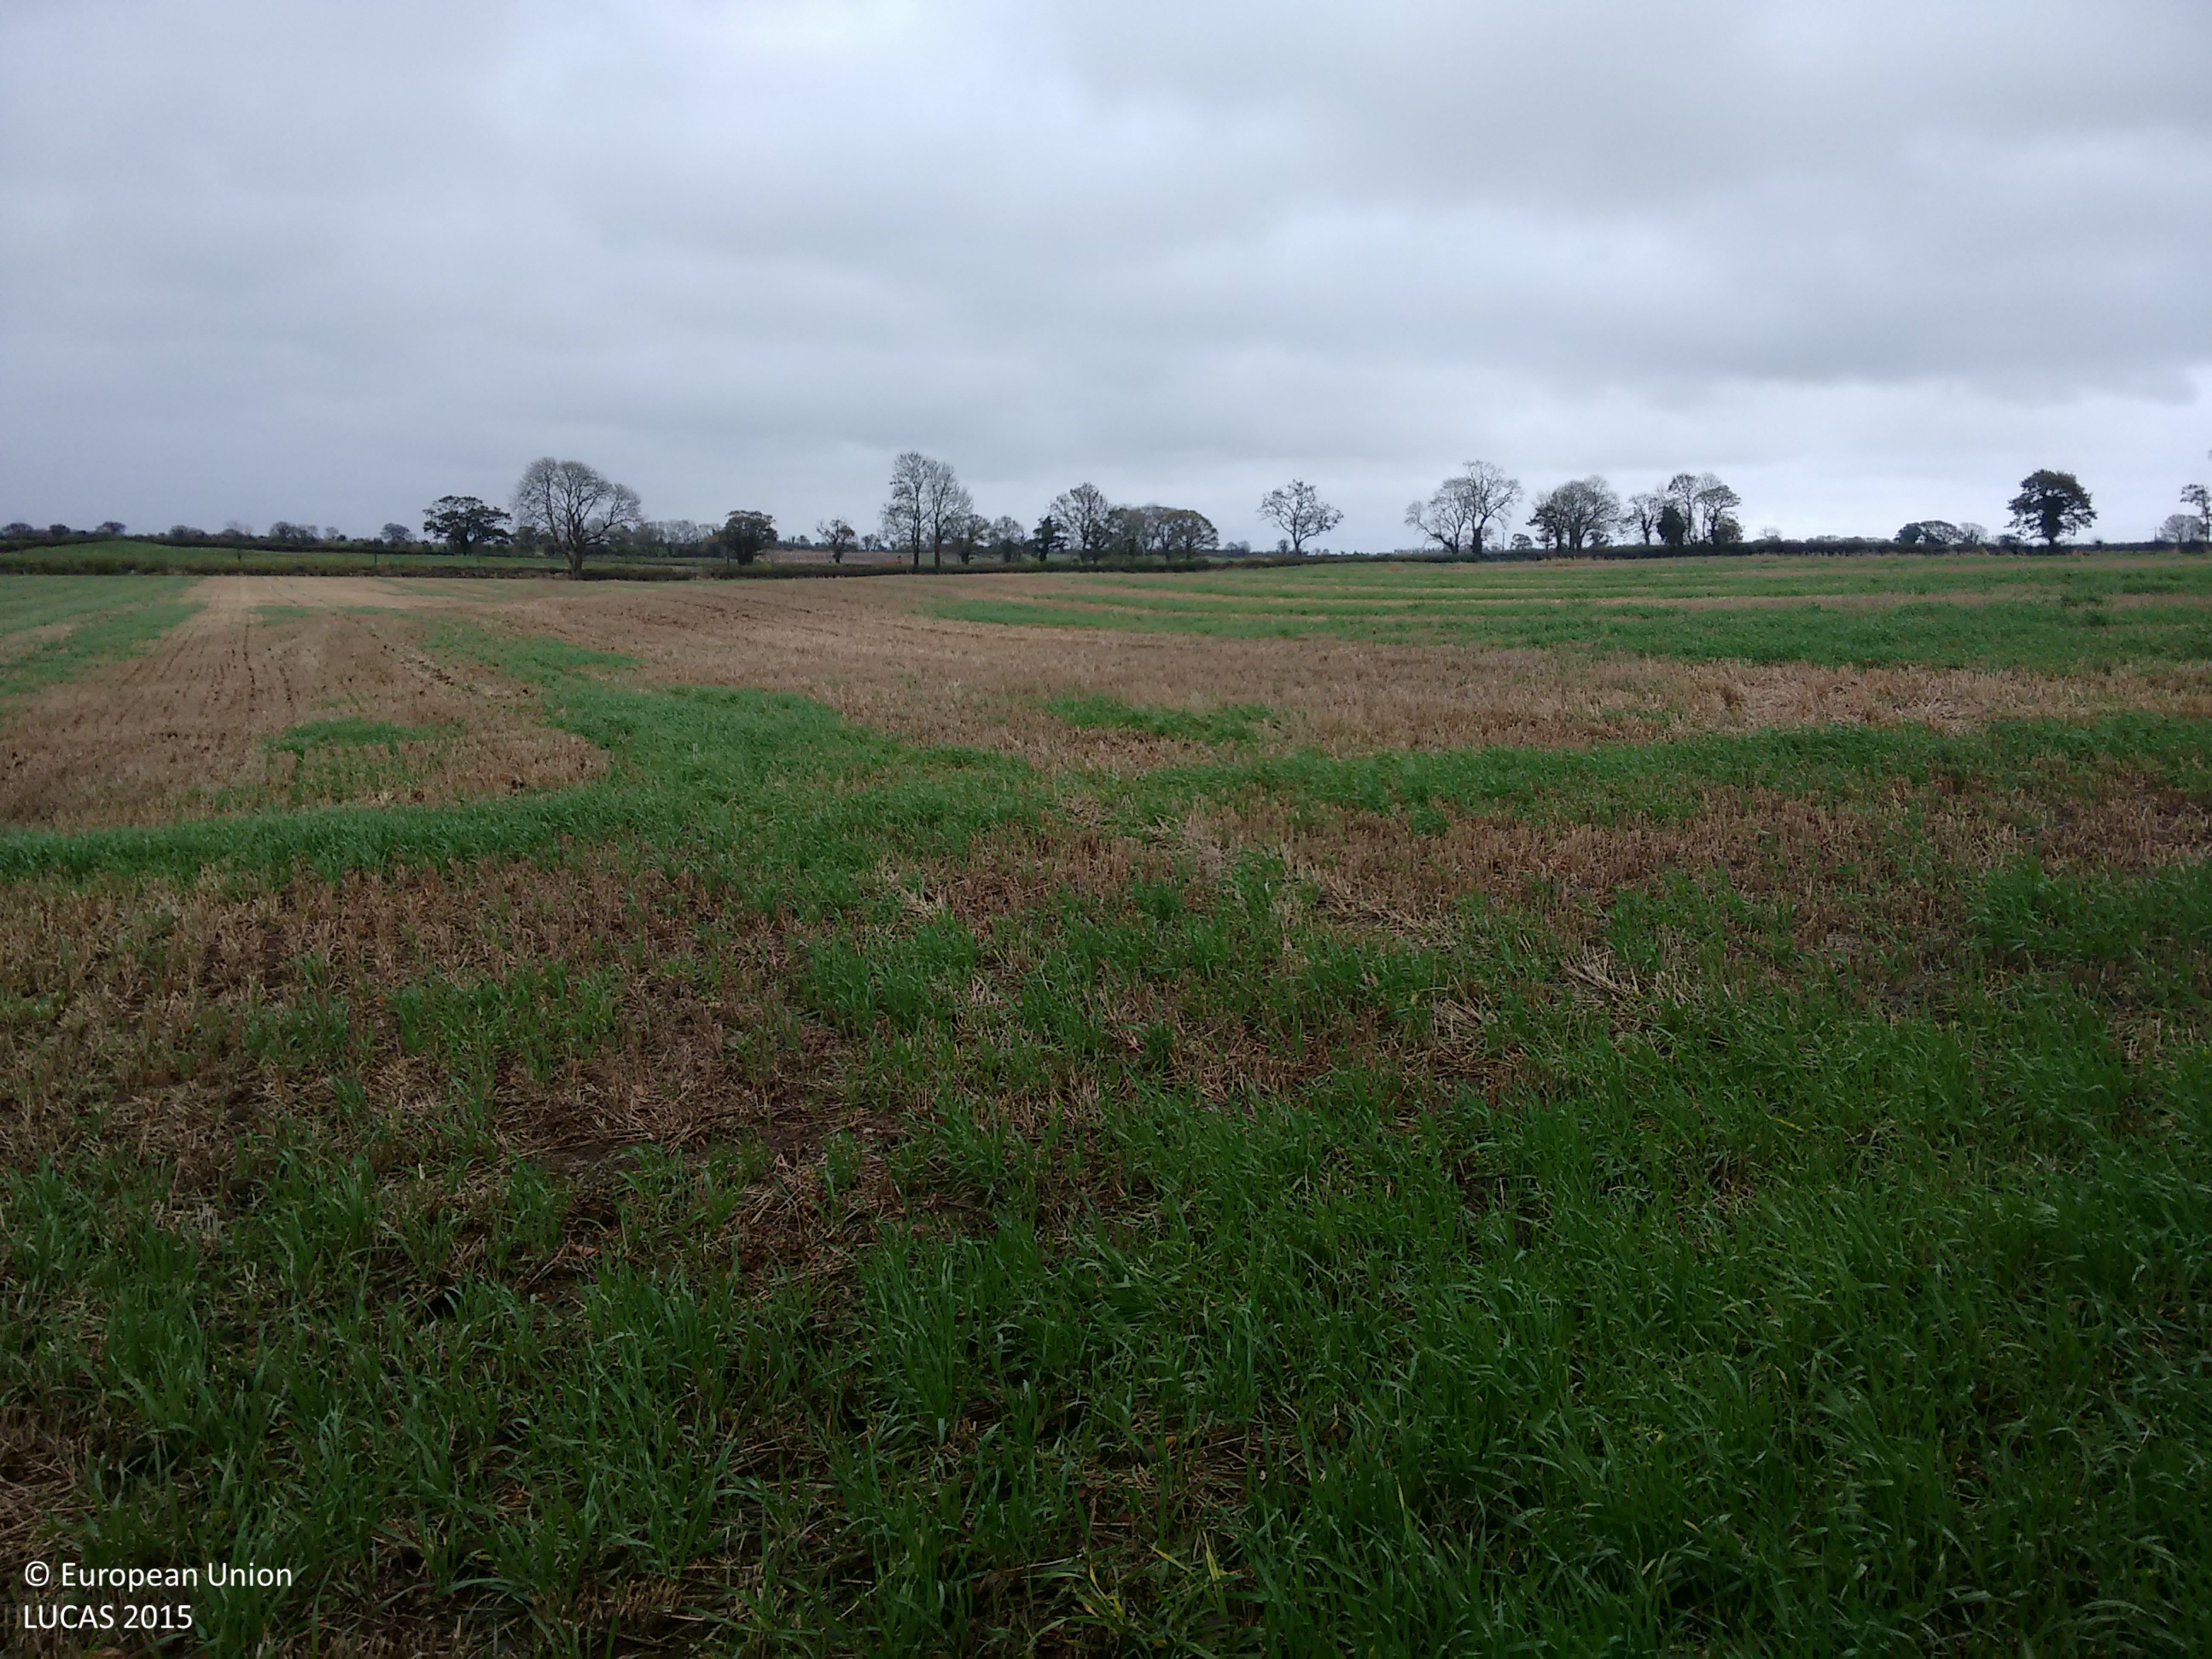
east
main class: Grassland
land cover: Grassland without tree/shrub cover
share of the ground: > 75 %
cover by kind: herbaceous plants 85 %, shrubs 5 %
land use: Agriculture (excluding fallow land and kitchen gardens)
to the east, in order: Grassland without tree/shrub cover; Fences; Grassland without tree/shrub cover
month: November
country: IE
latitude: 53.1901
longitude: -7.6905
